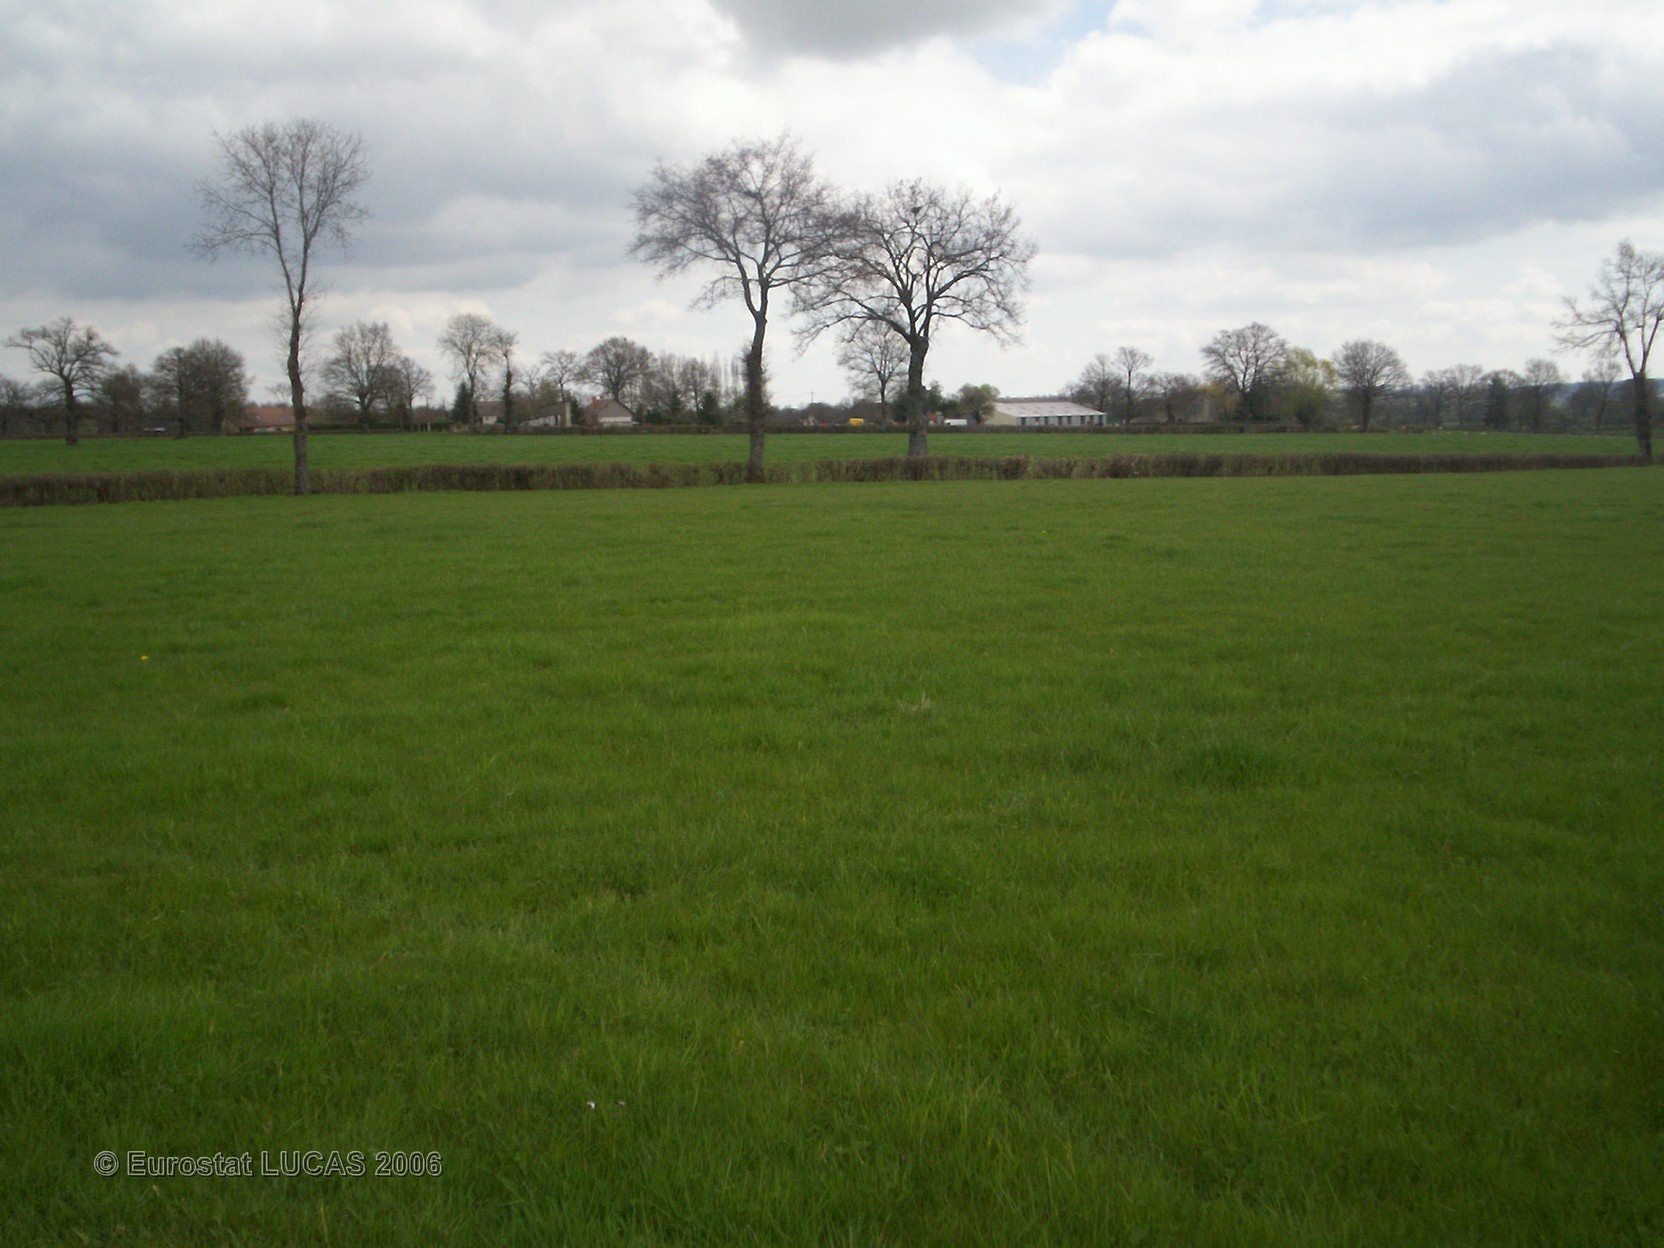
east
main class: Grassland
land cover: Grassland without tree/shrub cover
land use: Agriculture (excluding fallow land and kitchen gardens)
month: April
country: FR
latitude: 46.4151
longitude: 3.0633
